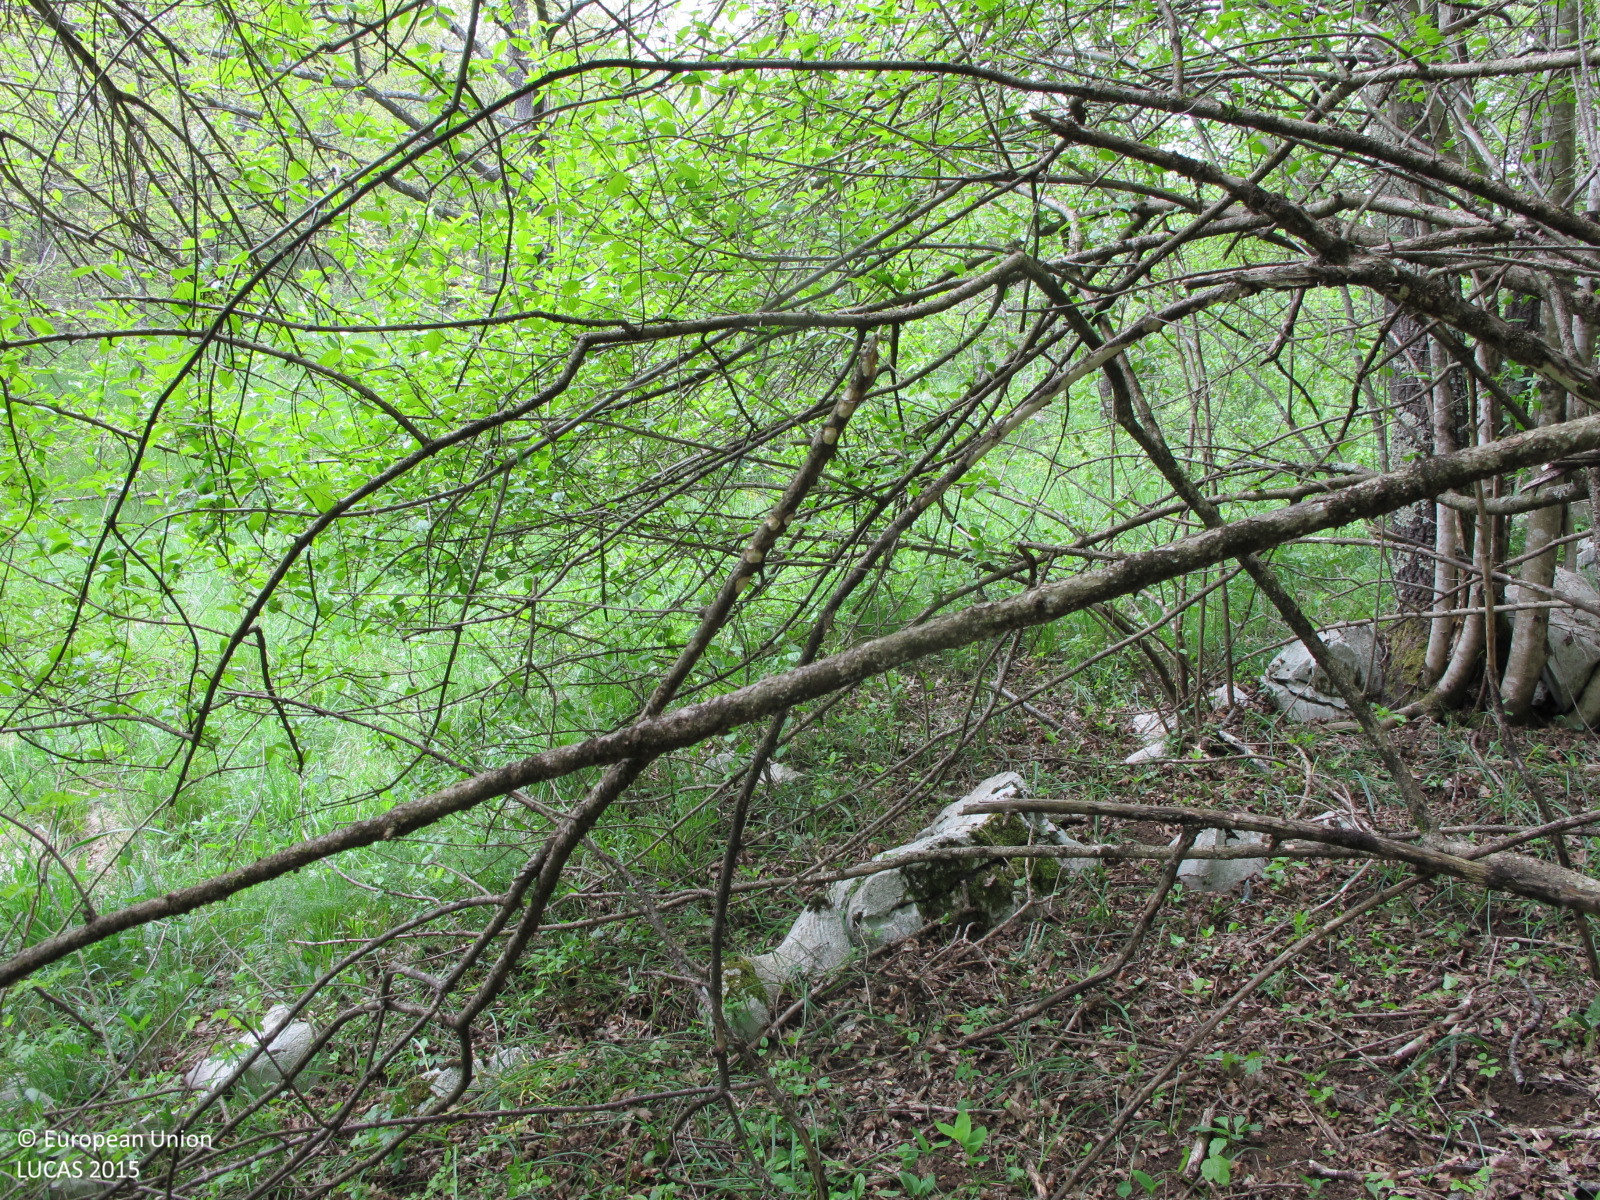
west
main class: Woodland
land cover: Broadleaved woodland
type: thermophilous deciduous forest
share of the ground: > 75 %
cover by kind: broadleaved forest trees 75 %, herbaceous plants 10 %, shrubs 5 %, consolidated bare surface 5 %
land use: Forestry
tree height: > 5 m
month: May
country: HR
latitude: 45.4178
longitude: 14.2761
